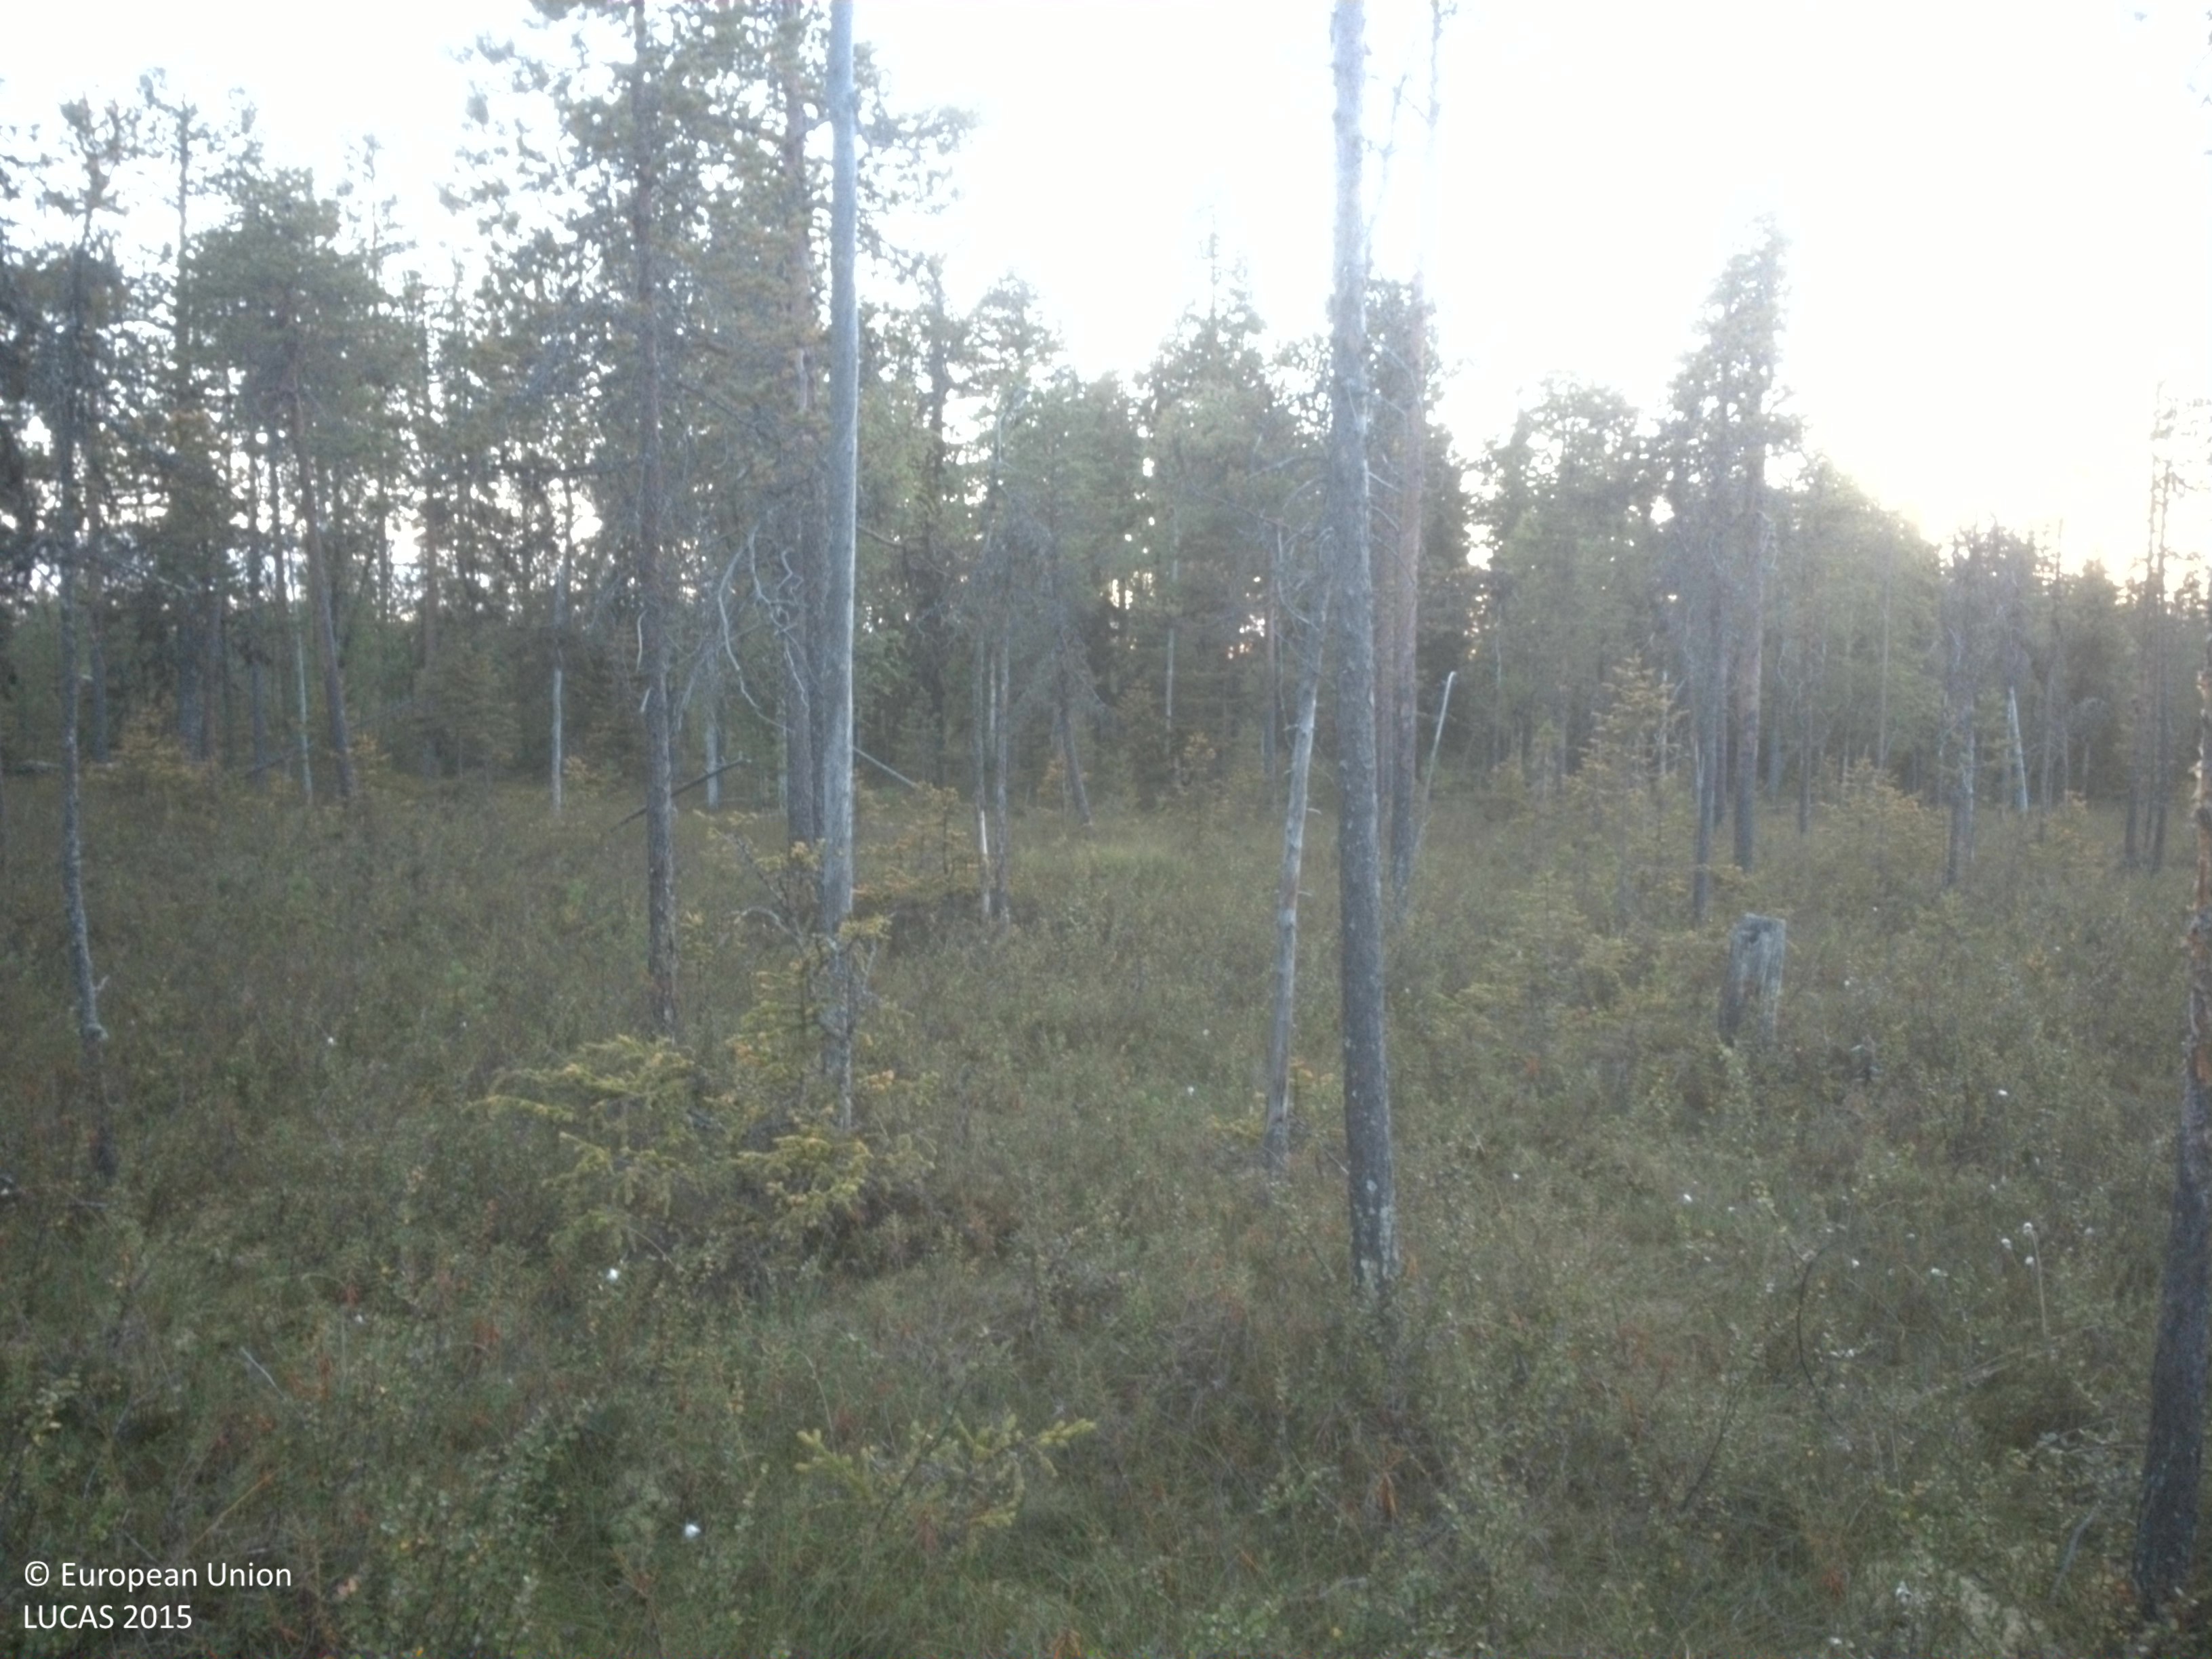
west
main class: Woodland
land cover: Pine dominated coniferous woodland
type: boreal forest
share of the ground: 10 - 25 %
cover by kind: shrubs 30 %, herbaceous plants 30 %, coniferous forest trees 20 %, lichens and mosses 20 %
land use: Forestry
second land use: Other primary production
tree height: > 5 m
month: August
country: SE
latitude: 64.6258
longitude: 18.8150
